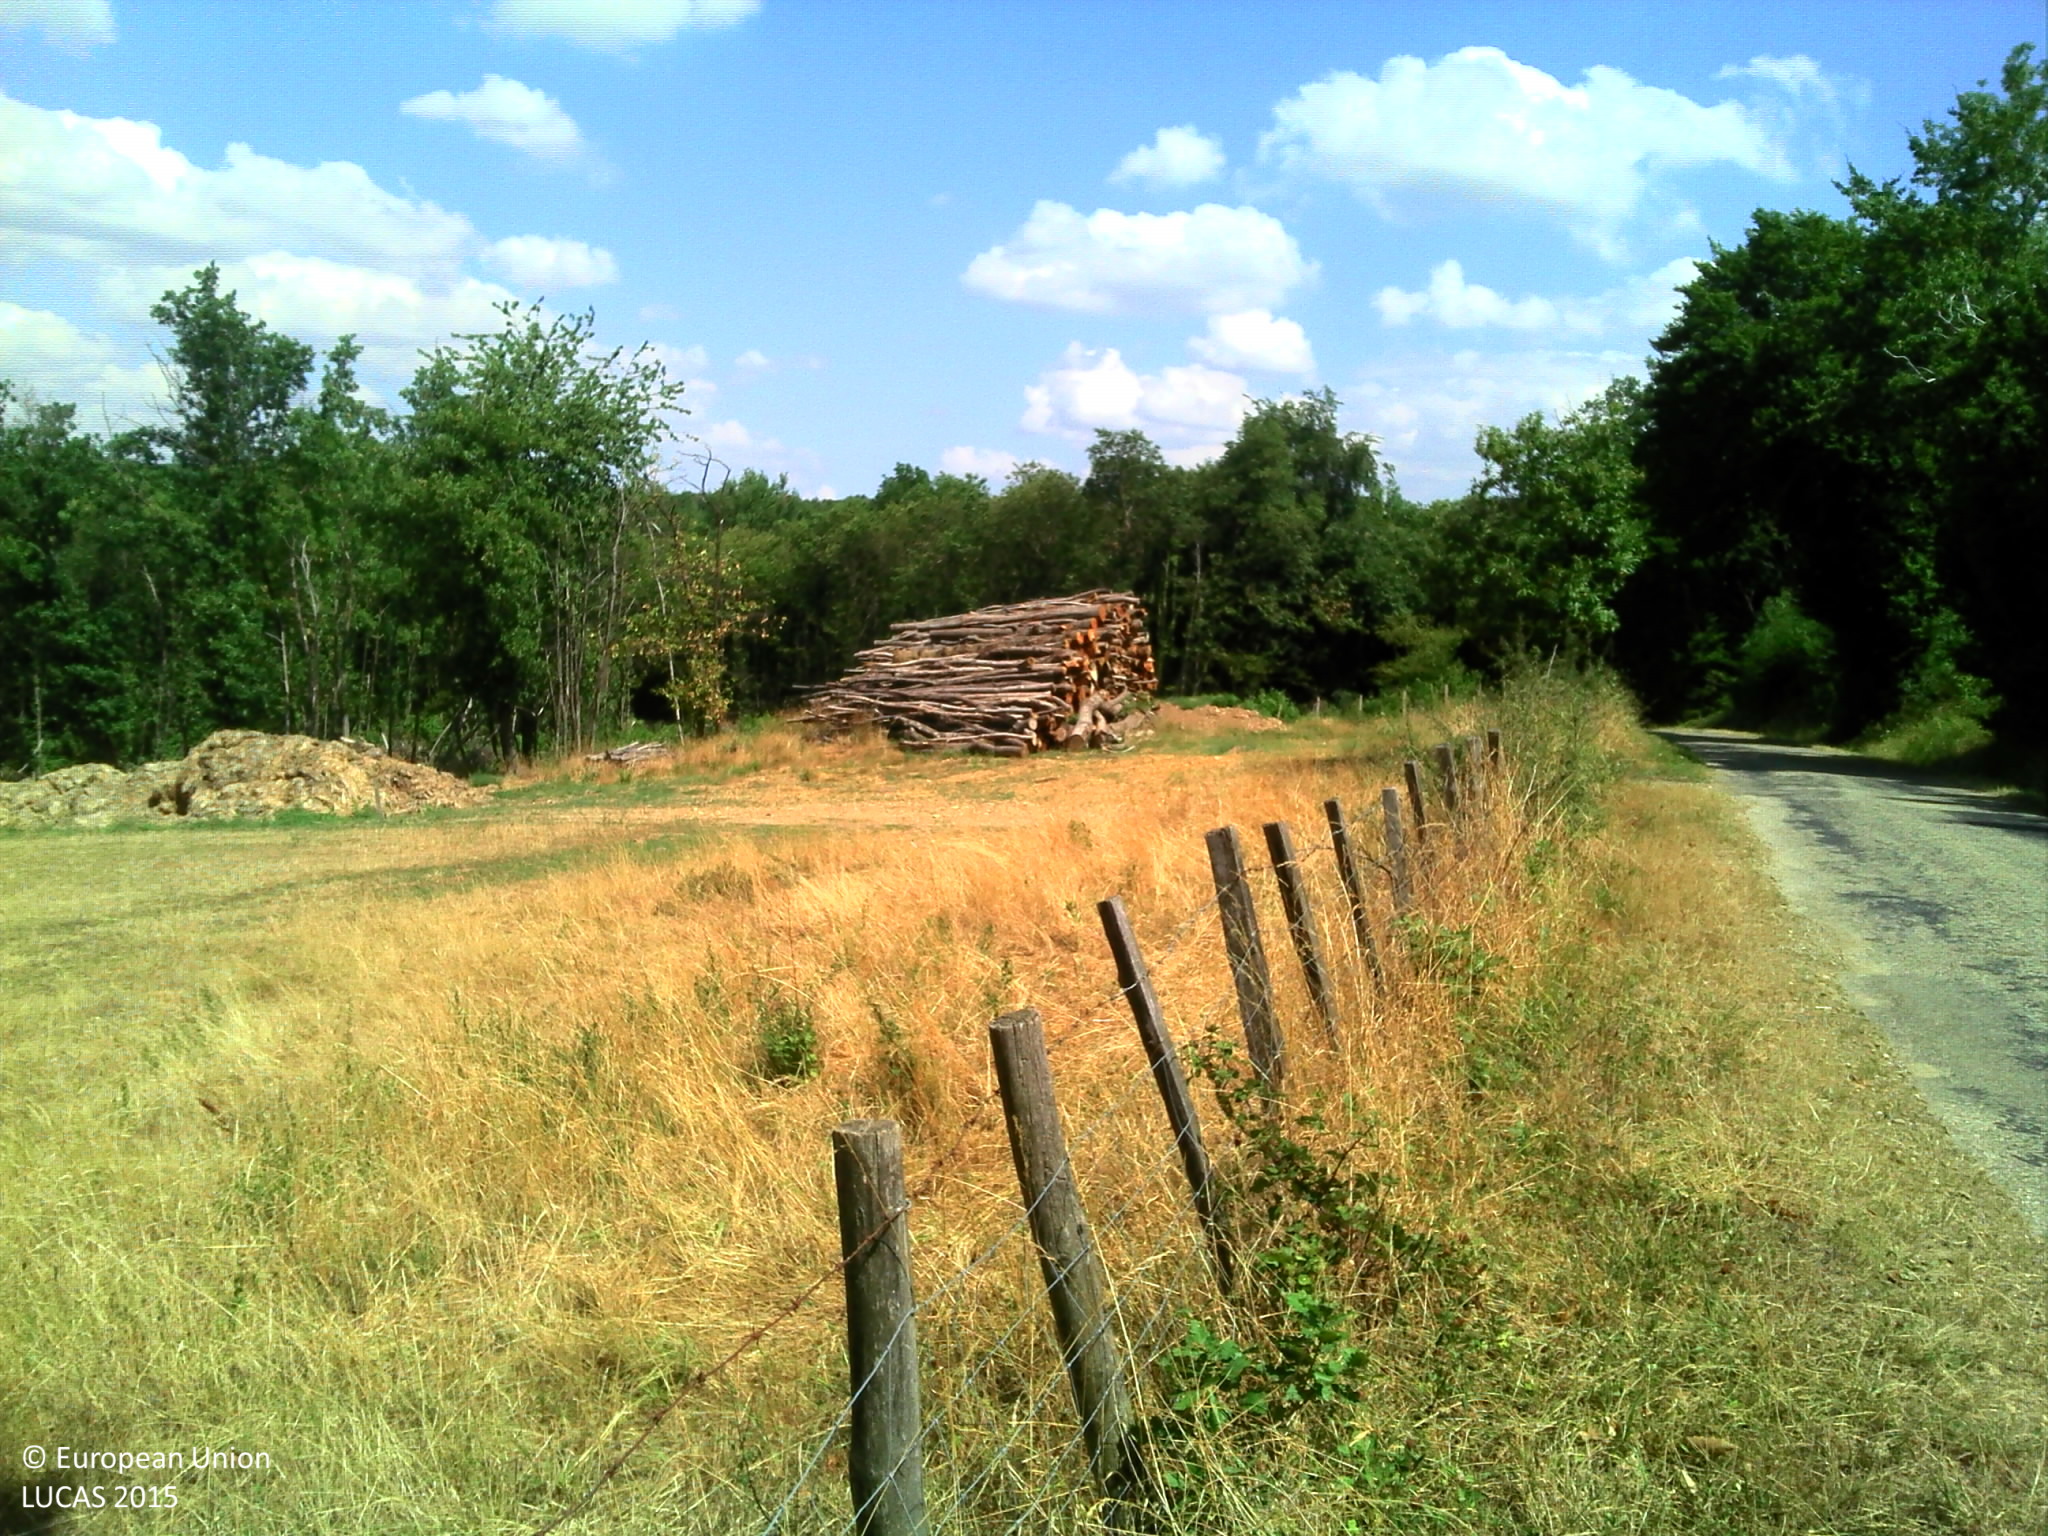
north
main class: Grassland
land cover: Grassland without tree/shrub cover
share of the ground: > 75 %
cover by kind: herbaceous plants 100 %
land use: Agriculture (excluding fallow land and kitchen gardens)
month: July
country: FR
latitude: 45.4882
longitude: 4.8735
